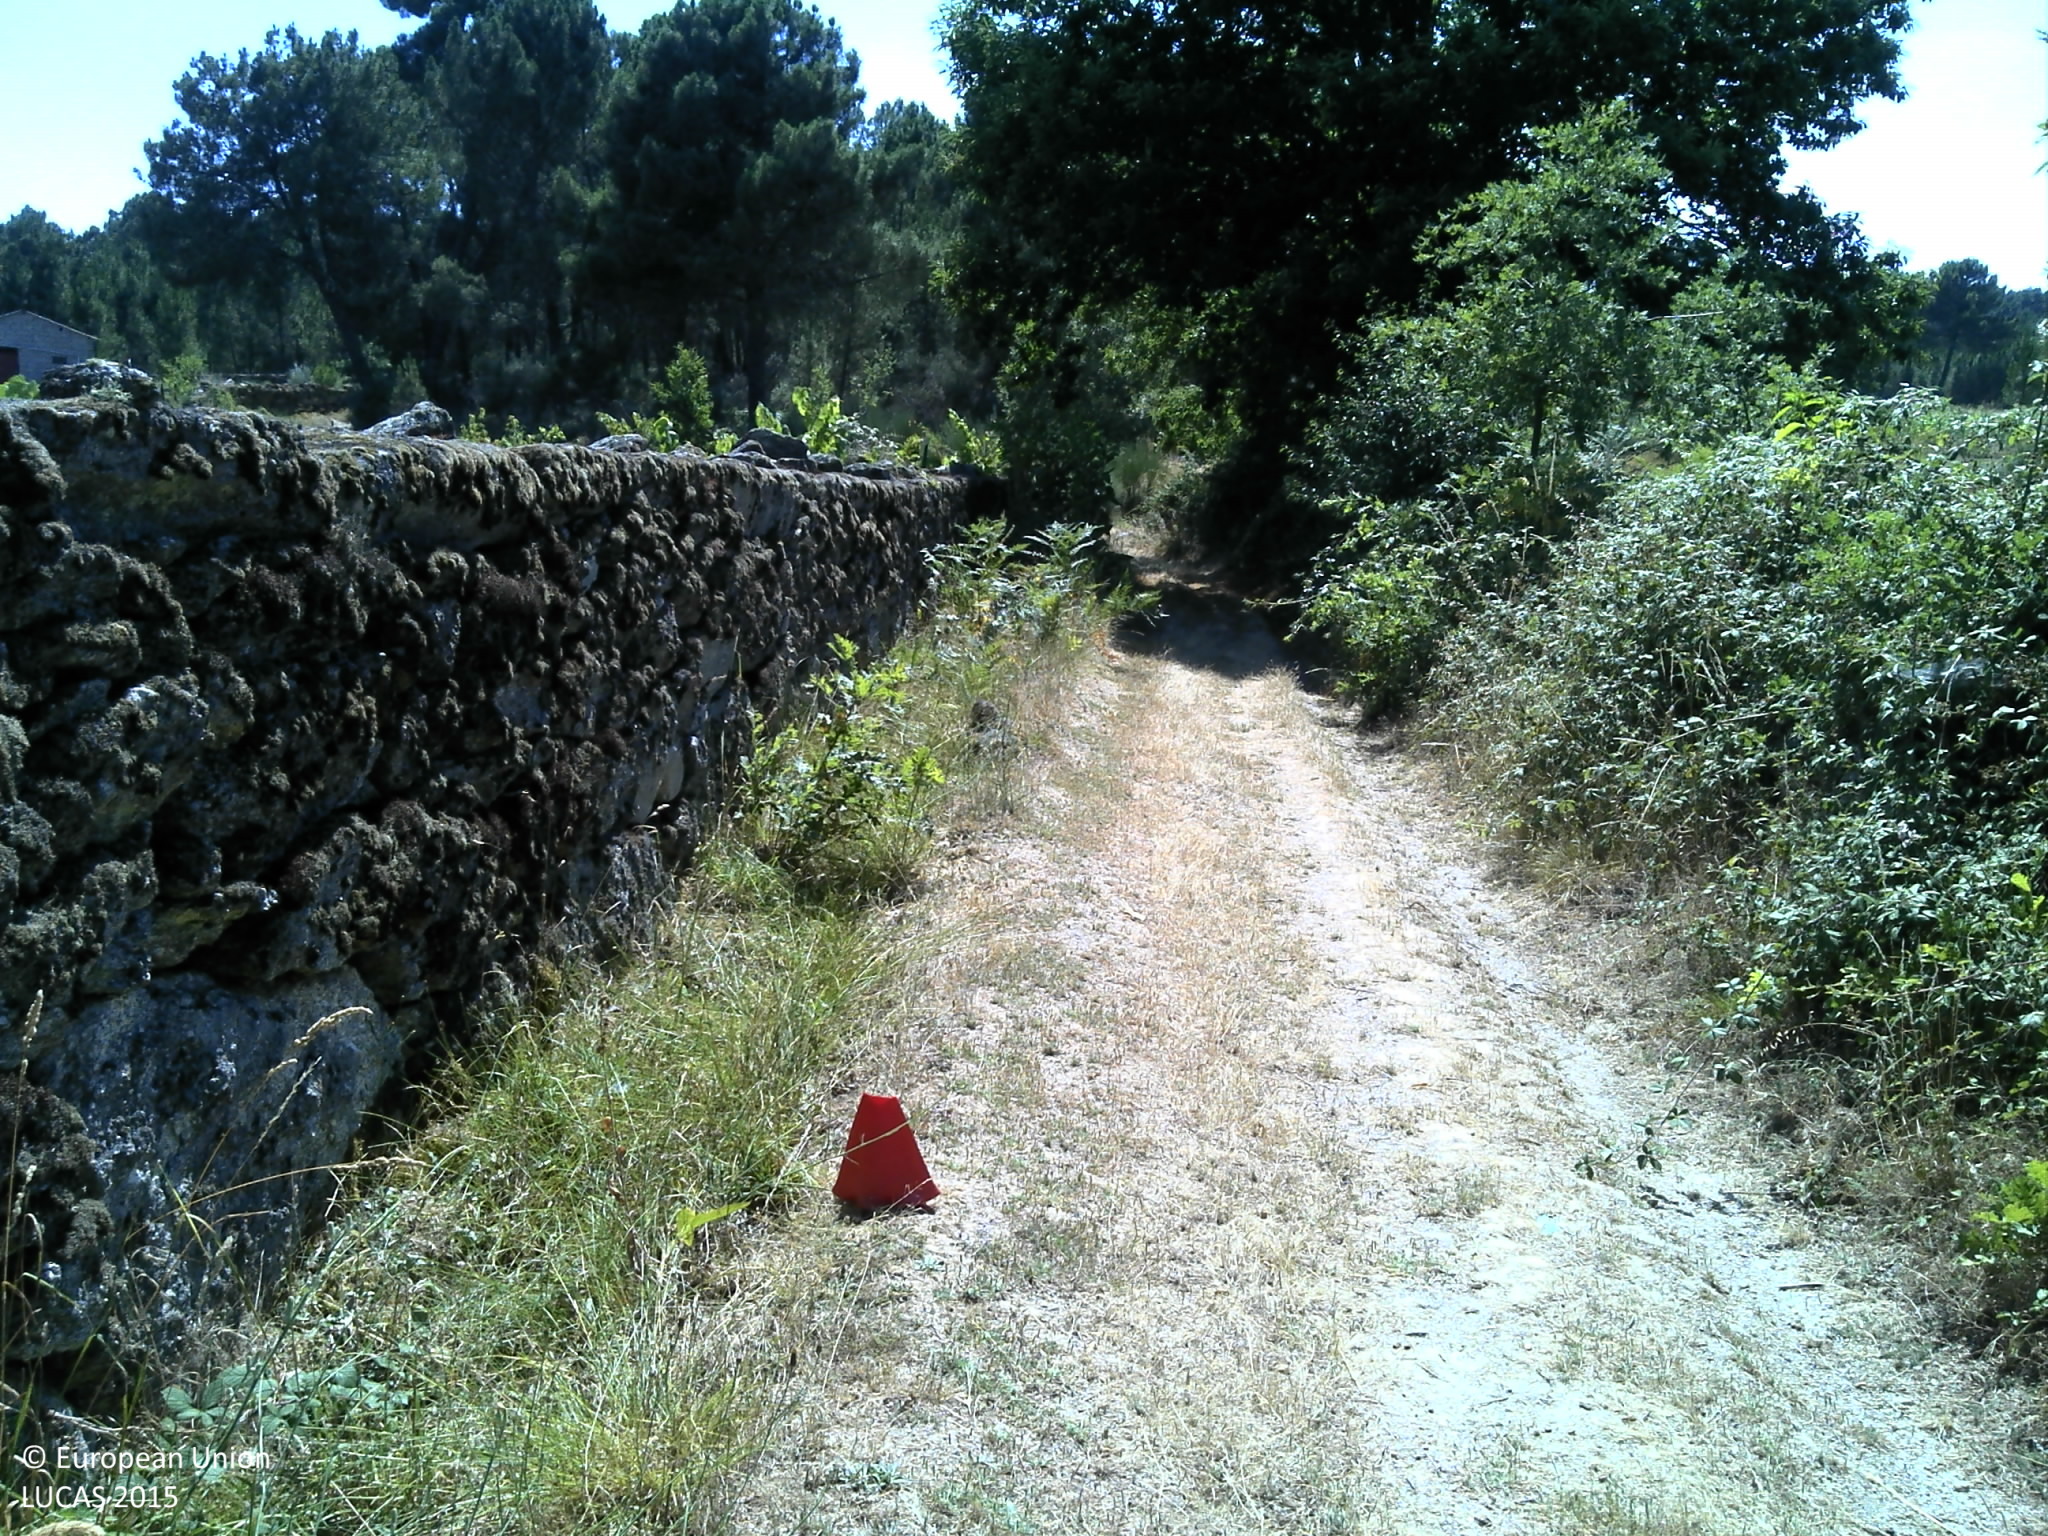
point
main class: Grassland
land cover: Grassland without tree/shrub cover
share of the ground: > 75 %
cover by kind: herbaceous plants 75 %, unconsolidated bare surface 20 %, shrubs 5 %
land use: Abandoned areas
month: July
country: PT
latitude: 40.8372
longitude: -7.5146
